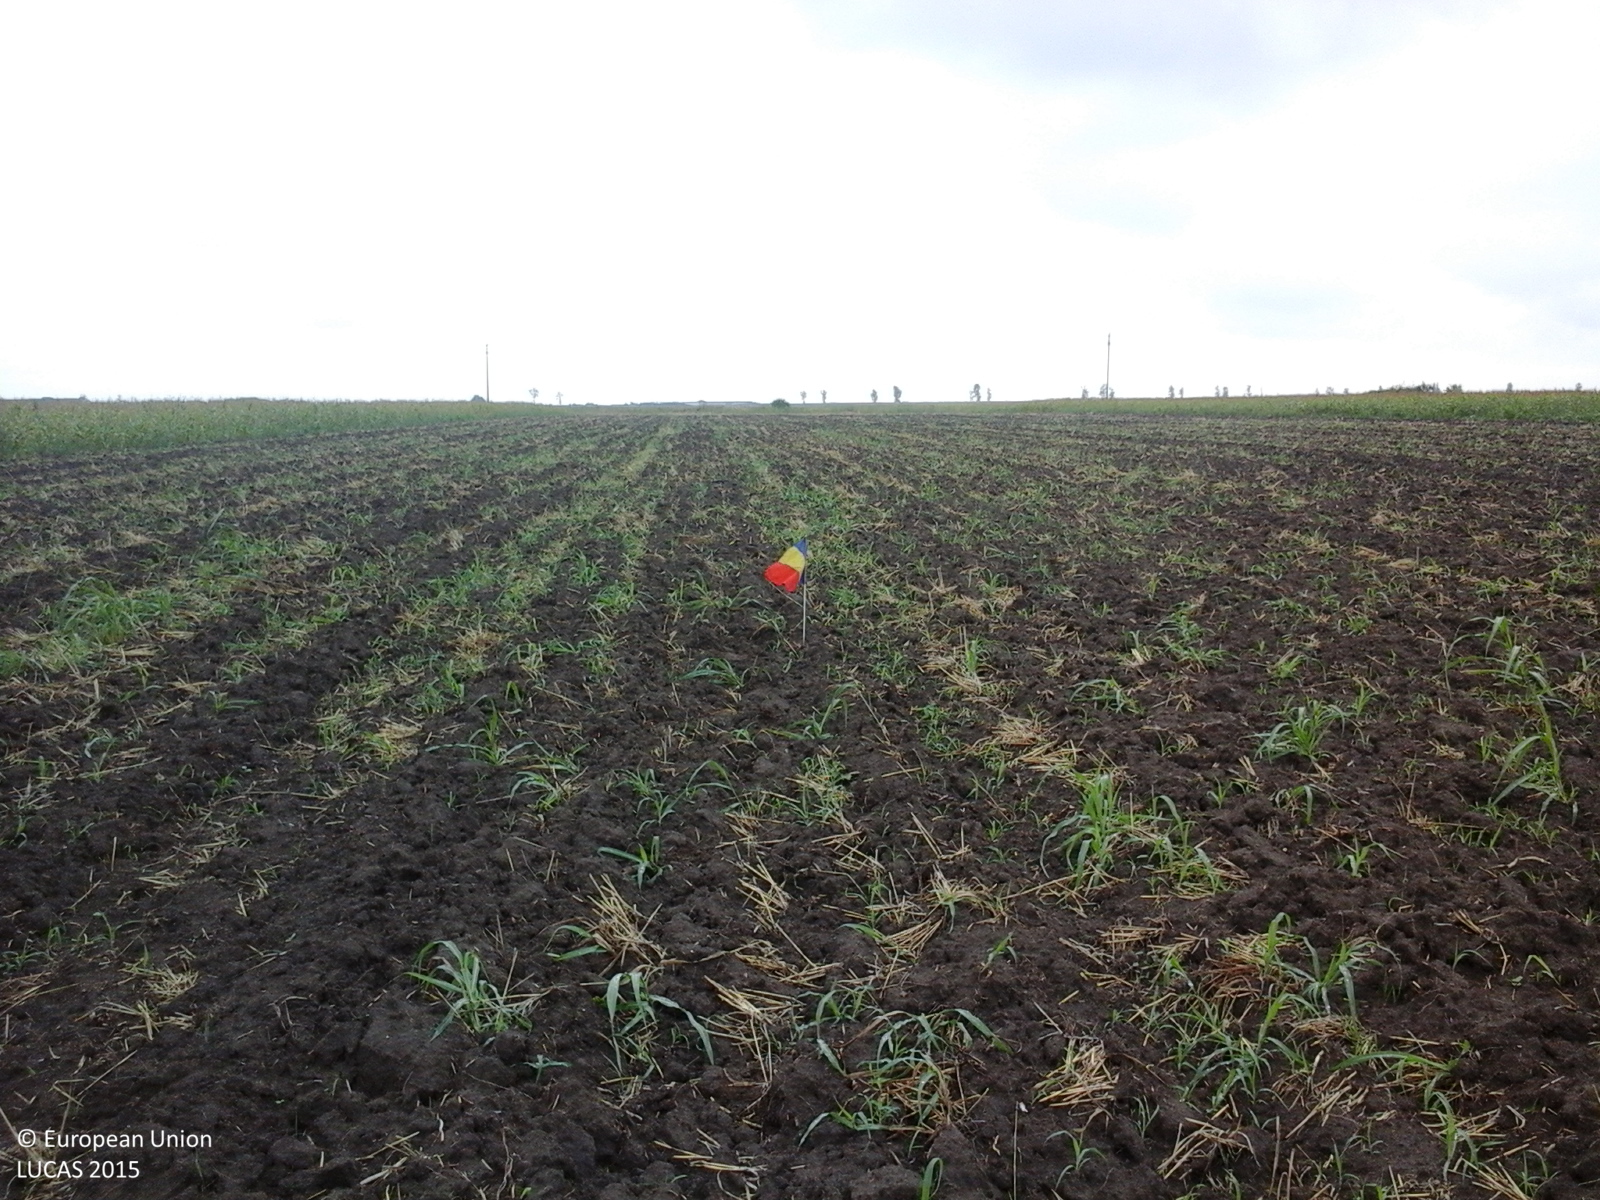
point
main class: Cropland
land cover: Common wheat
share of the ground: < 10 %
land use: Agriculture (excluding fallow land and kitchen gardens)
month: August
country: RO
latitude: 46.0375
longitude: 20.4512
